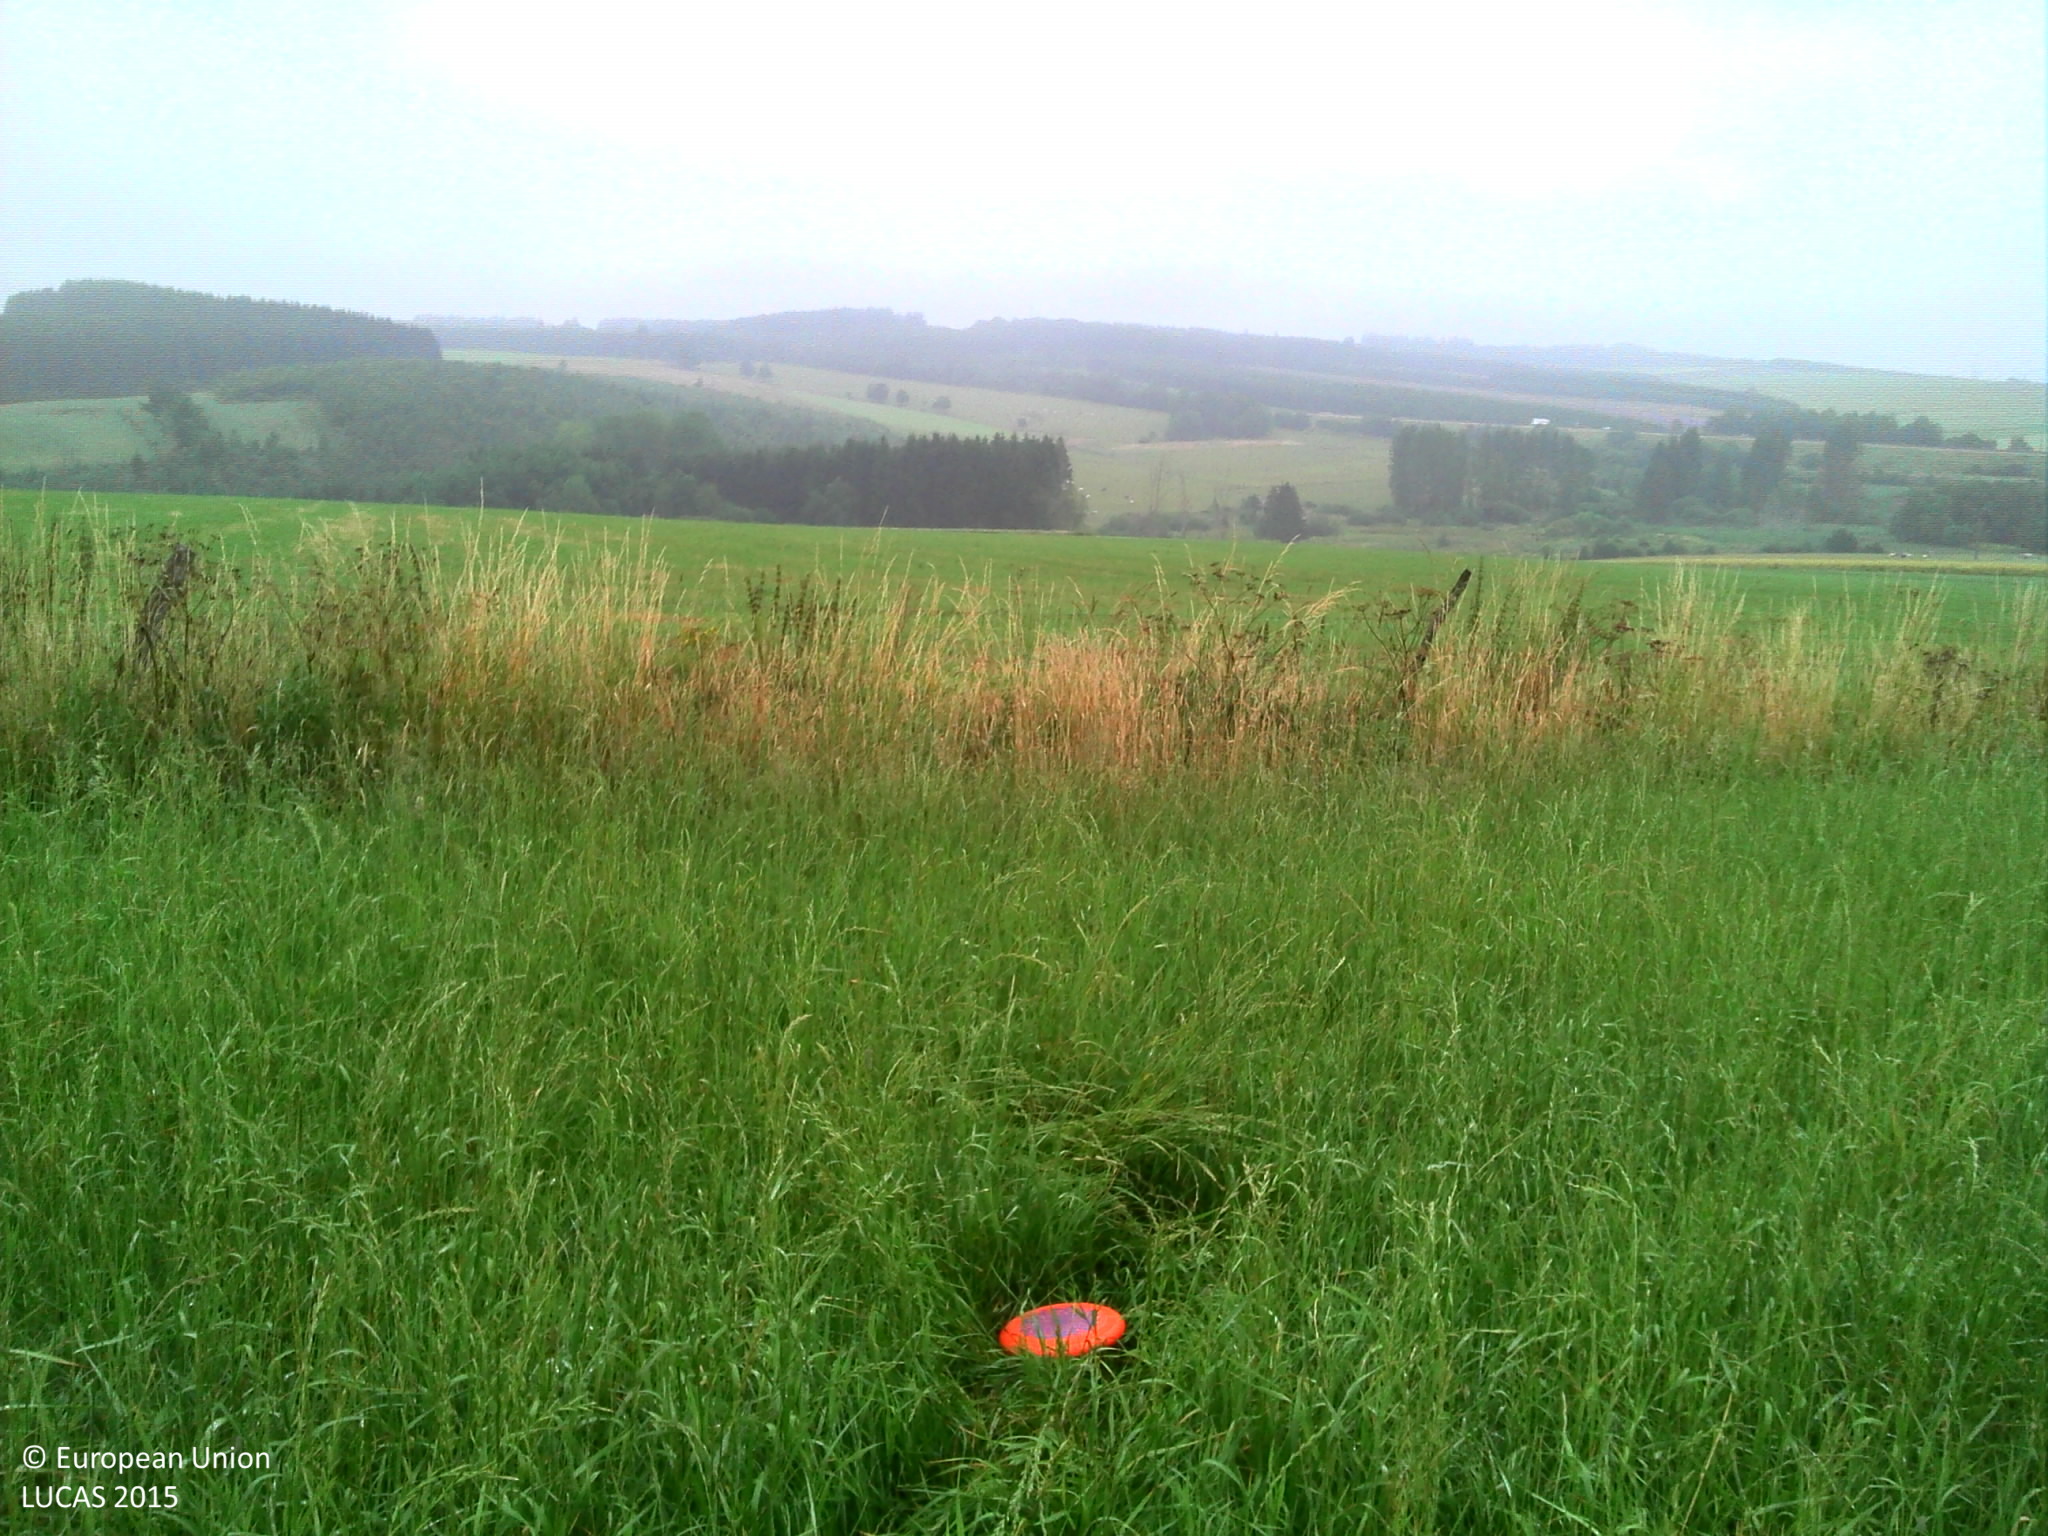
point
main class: Grassland
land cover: Grassland without tree/shrub cover
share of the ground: > 75 %
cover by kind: herbaceous plants 100 %
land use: Agriculture (excluding fallow land and kitchen gardens)
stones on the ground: < 10 %
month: July
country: BE
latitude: 50.0865
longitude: 5.7359
